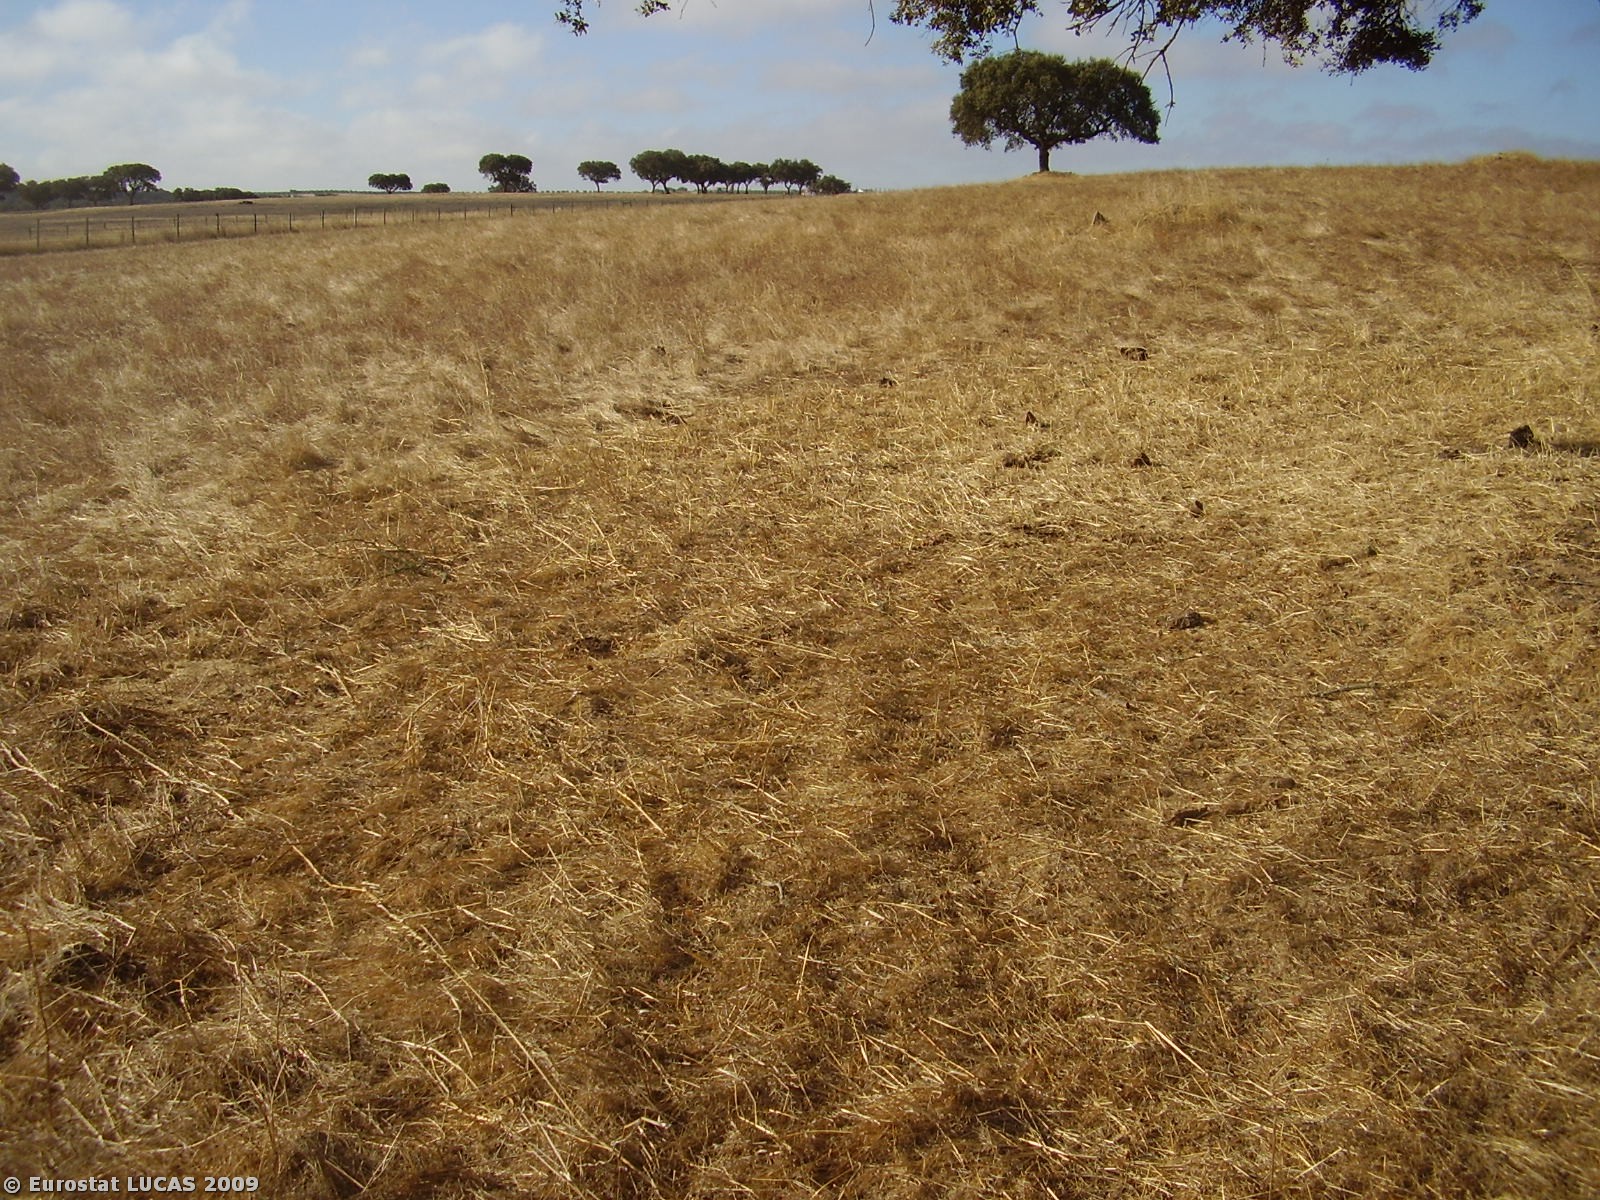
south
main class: Grassland
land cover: Grassland with sparse tree/shrub cover
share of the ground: > 75 %
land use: Fallow land
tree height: > 5 m
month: August
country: PT
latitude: 38.1114
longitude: -7.9726
